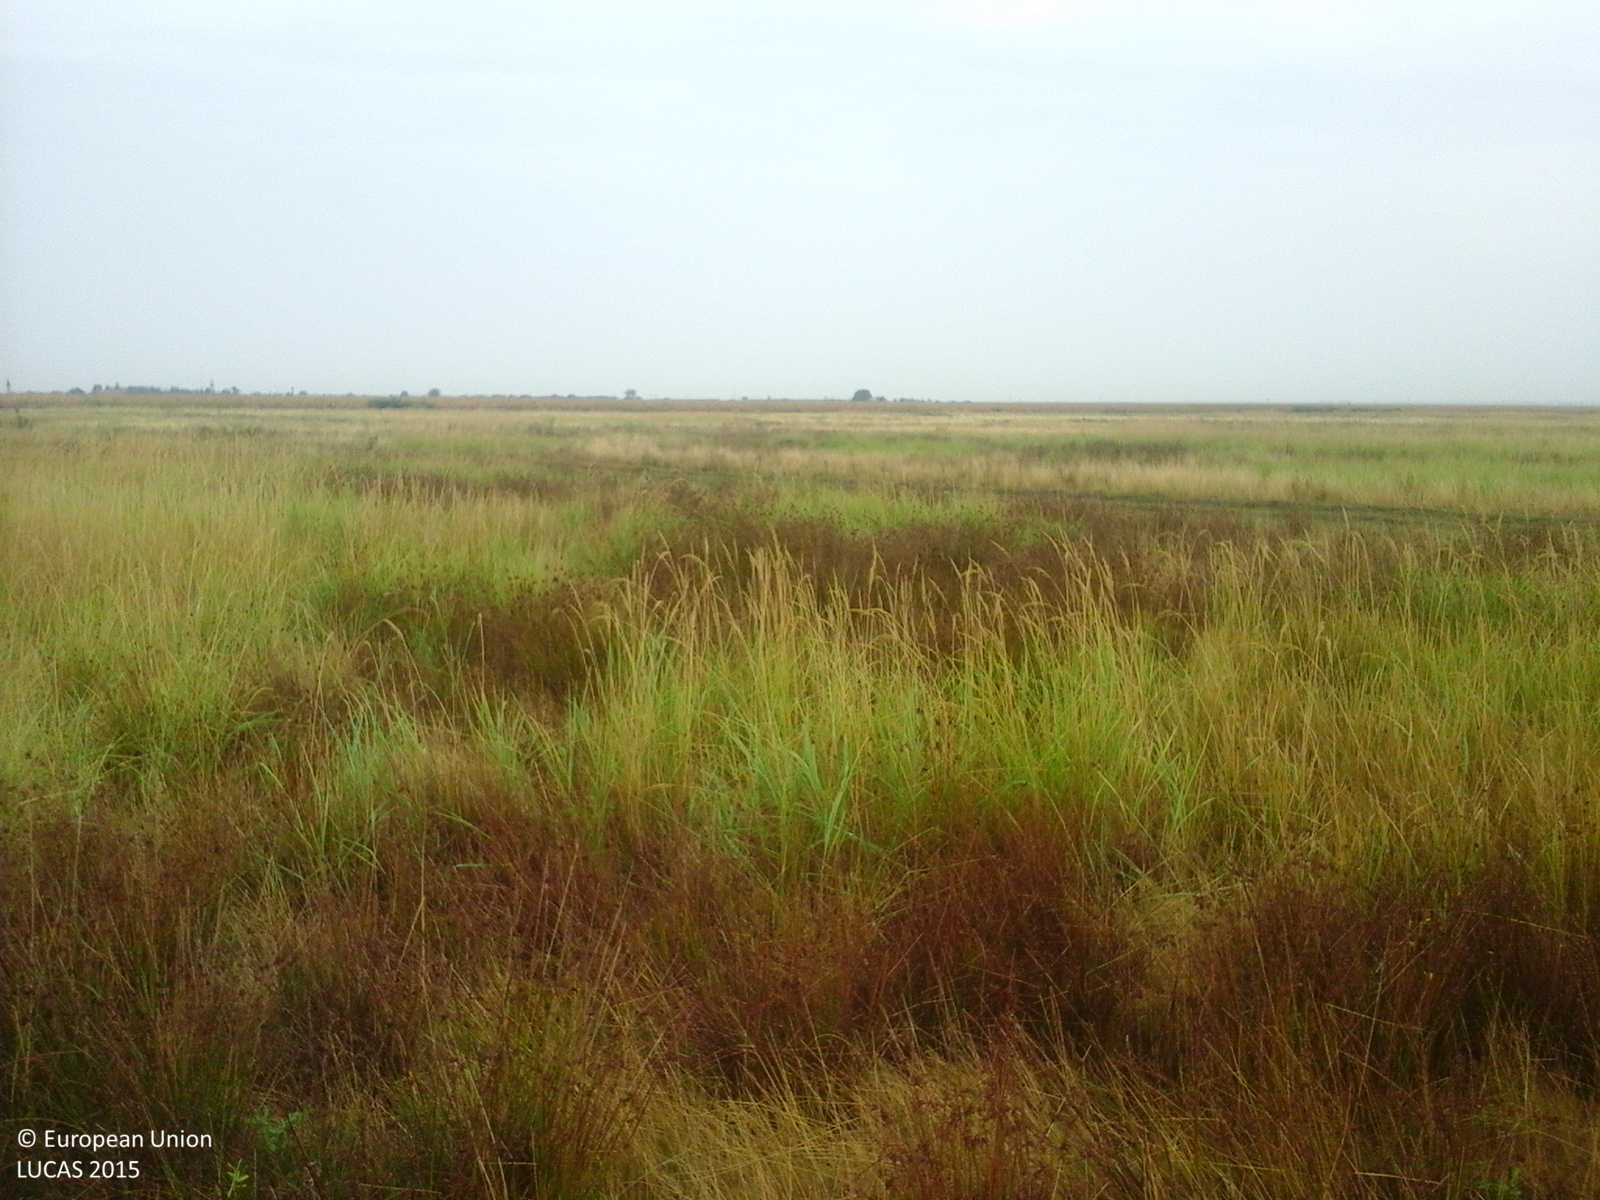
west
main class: Grassland
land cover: Spontaneously vegetated surfaces
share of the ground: > 75 %
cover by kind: herbaceous plants 100 %
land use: Fallow land
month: September
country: RO
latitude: 47.5737
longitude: 22.5679
